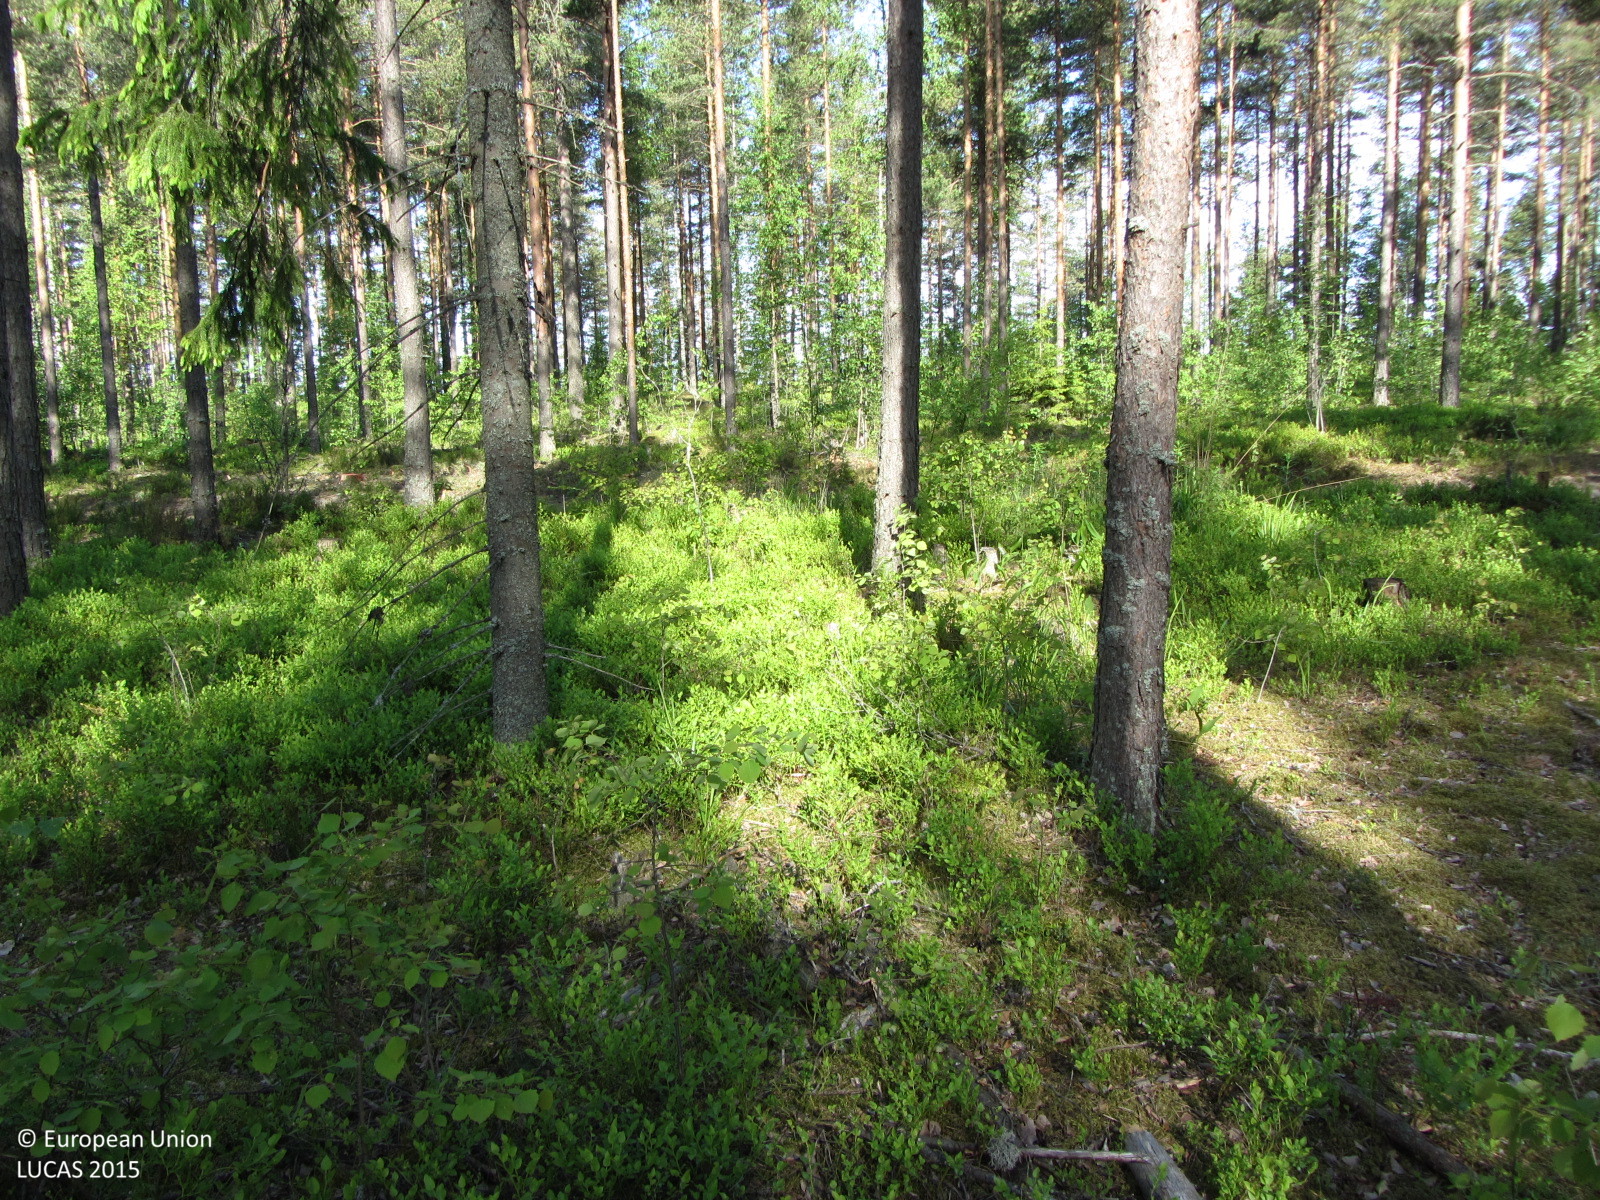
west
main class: Woodland
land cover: Other mixed woodland
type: boreal forest
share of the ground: > 75 %
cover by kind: coniferous forest trees 55 %, broadleaved forest trees 30 %, shrubs 5 %, lichens and mosses 5 %, unconsolidated bare surface 5 %
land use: Forestry
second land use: Amenities, museums, leisure
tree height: > 5 m
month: June
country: FI
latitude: 60.3288
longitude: 24.2833
